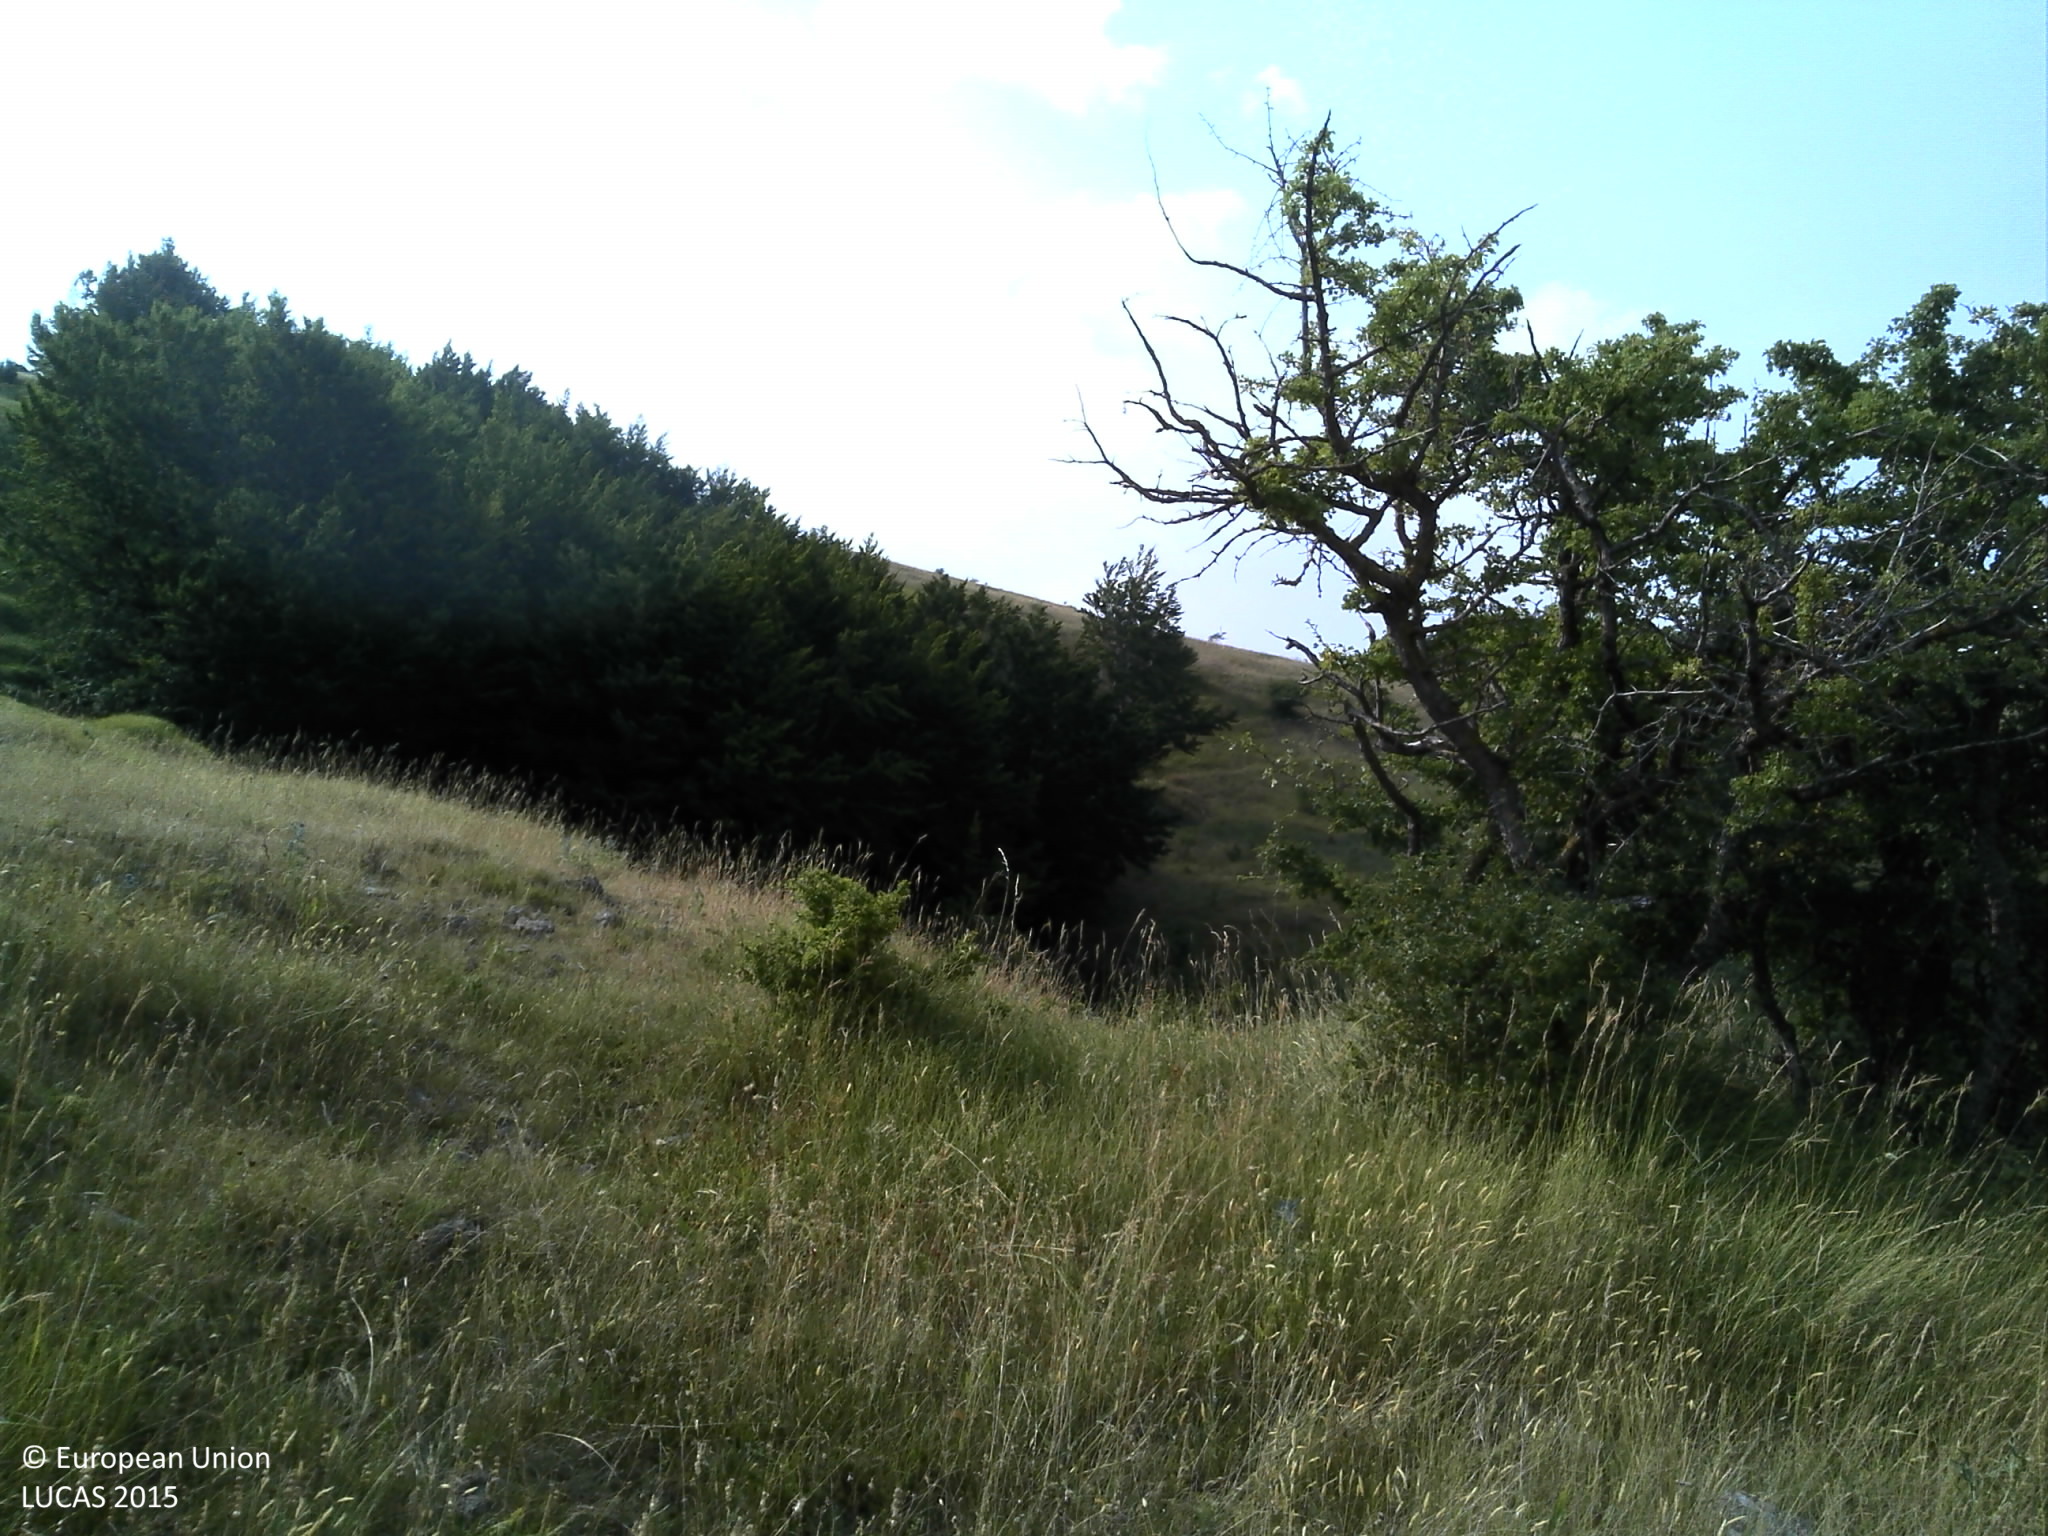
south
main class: Grassland
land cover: Grassland without tree/shrub cover
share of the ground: > 75 %
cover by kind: herbaceous plants 90 %, shrubs 5 %, consolidated bare surface 5 %
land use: Abandoned areas
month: July
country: HR
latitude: 44.3231
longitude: 15.9744
